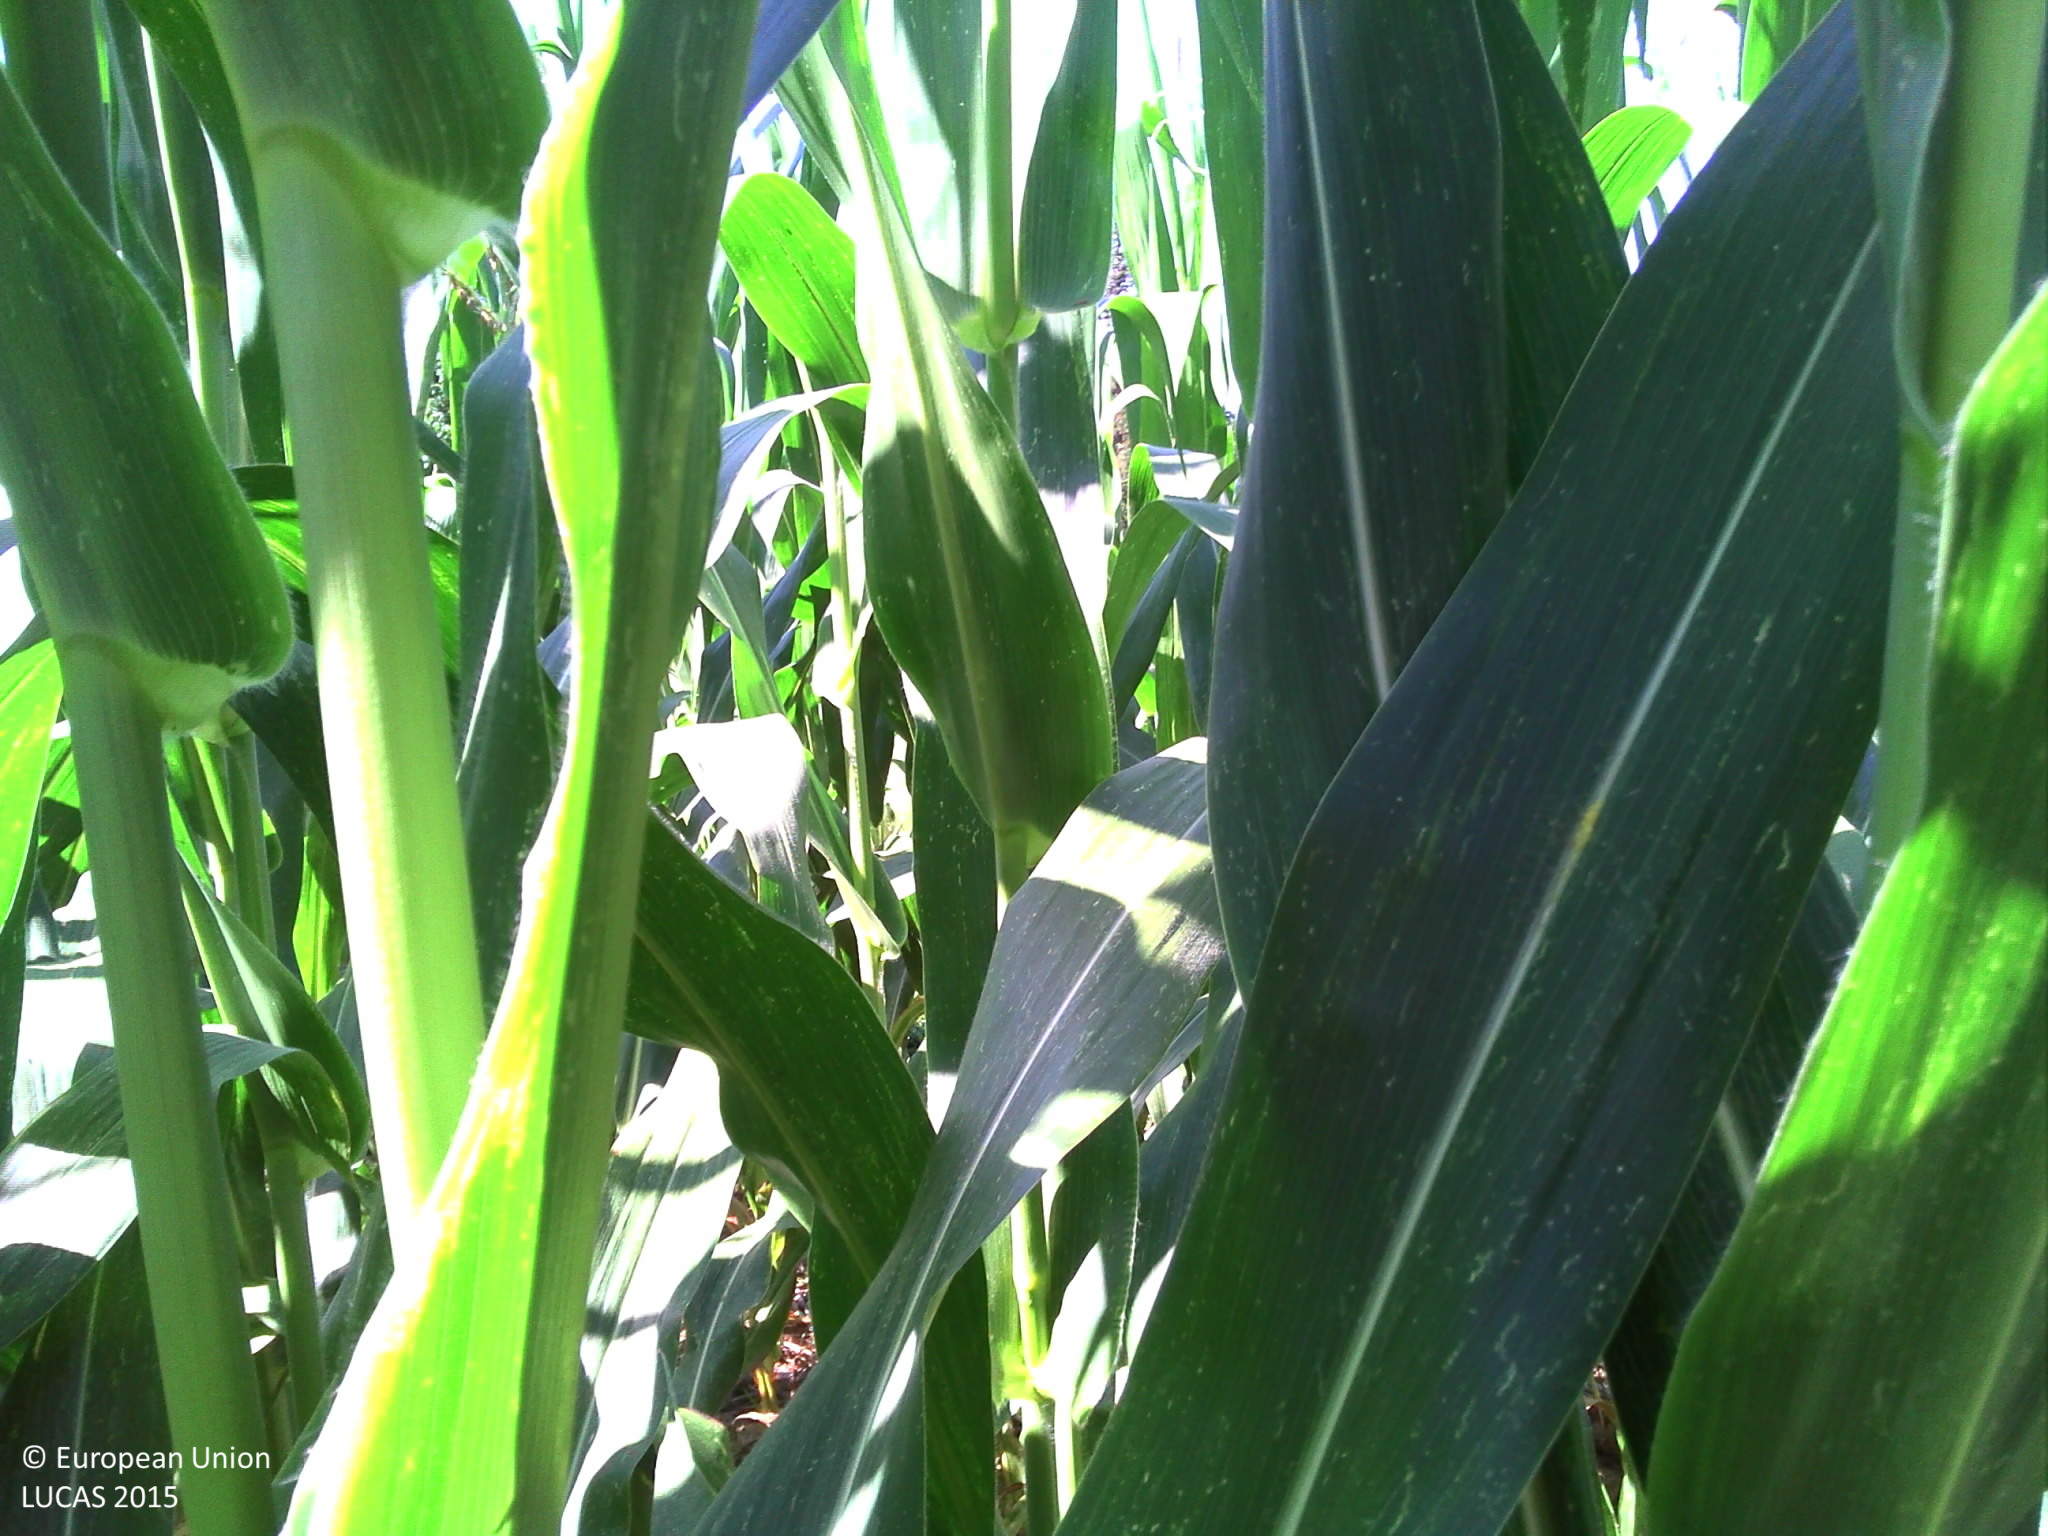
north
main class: Cropland
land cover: Maize
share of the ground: > 75 %
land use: Agriculture (excluding fallow land and kitchen gardens)
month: July
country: FR
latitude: 43.9515
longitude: 0.7134
